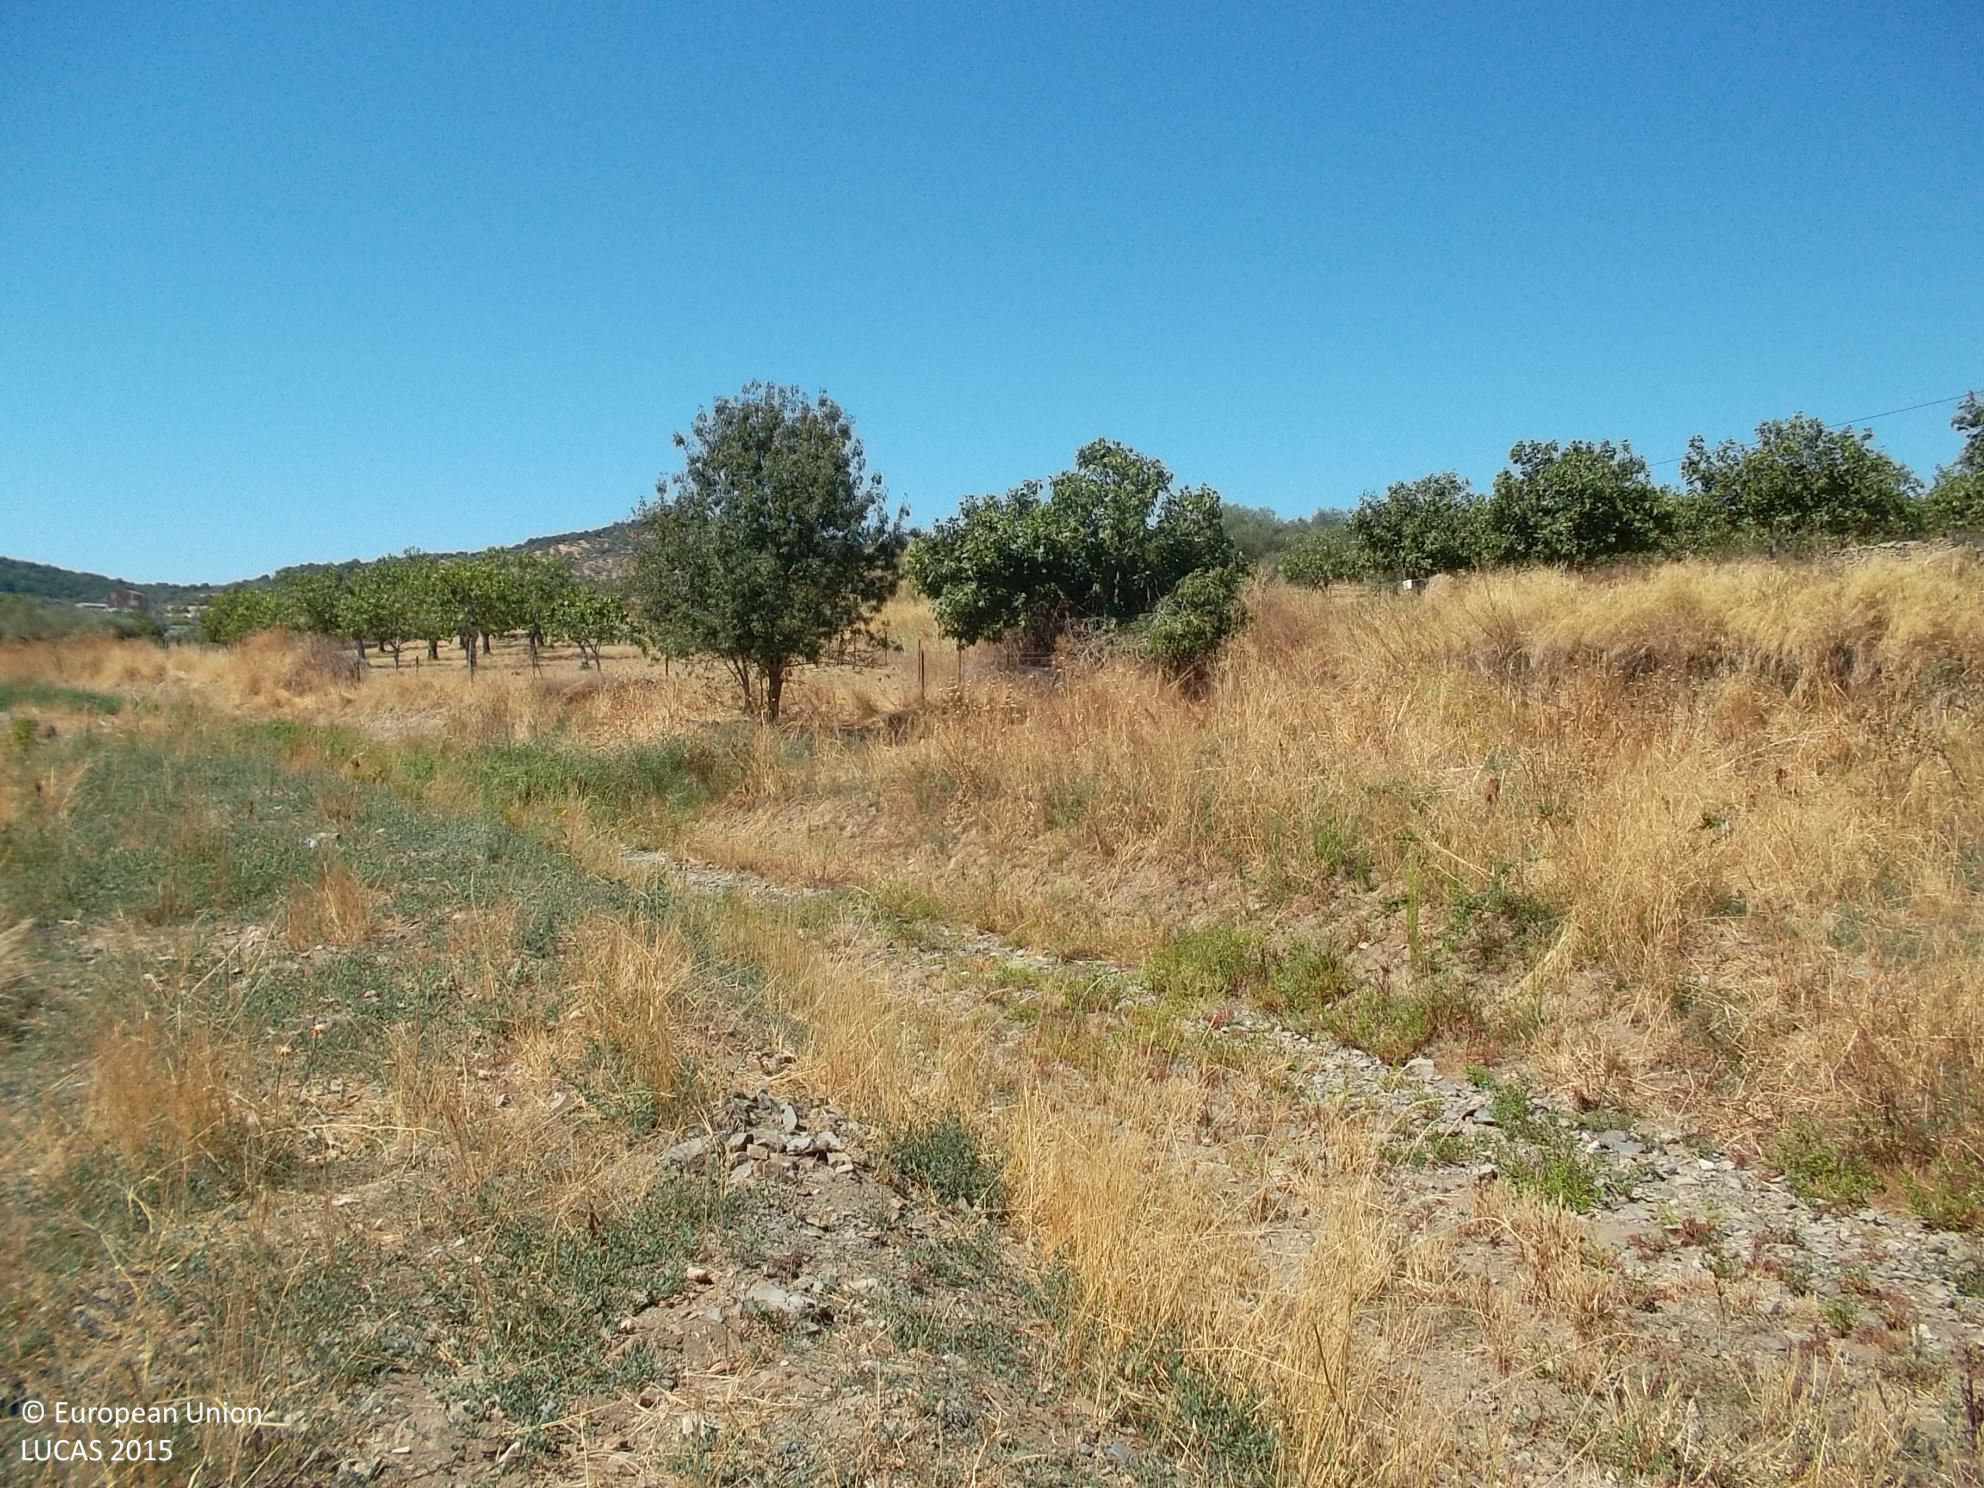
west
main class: Shrubland
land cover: Shrubland without tree cover
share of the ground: > 75 %
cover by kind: shrubs 50 %, herbaceous plants 50 %
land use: Semi-natural and natural areas not in use
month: August
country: ES
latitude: 38.4978
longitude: -6.6709
